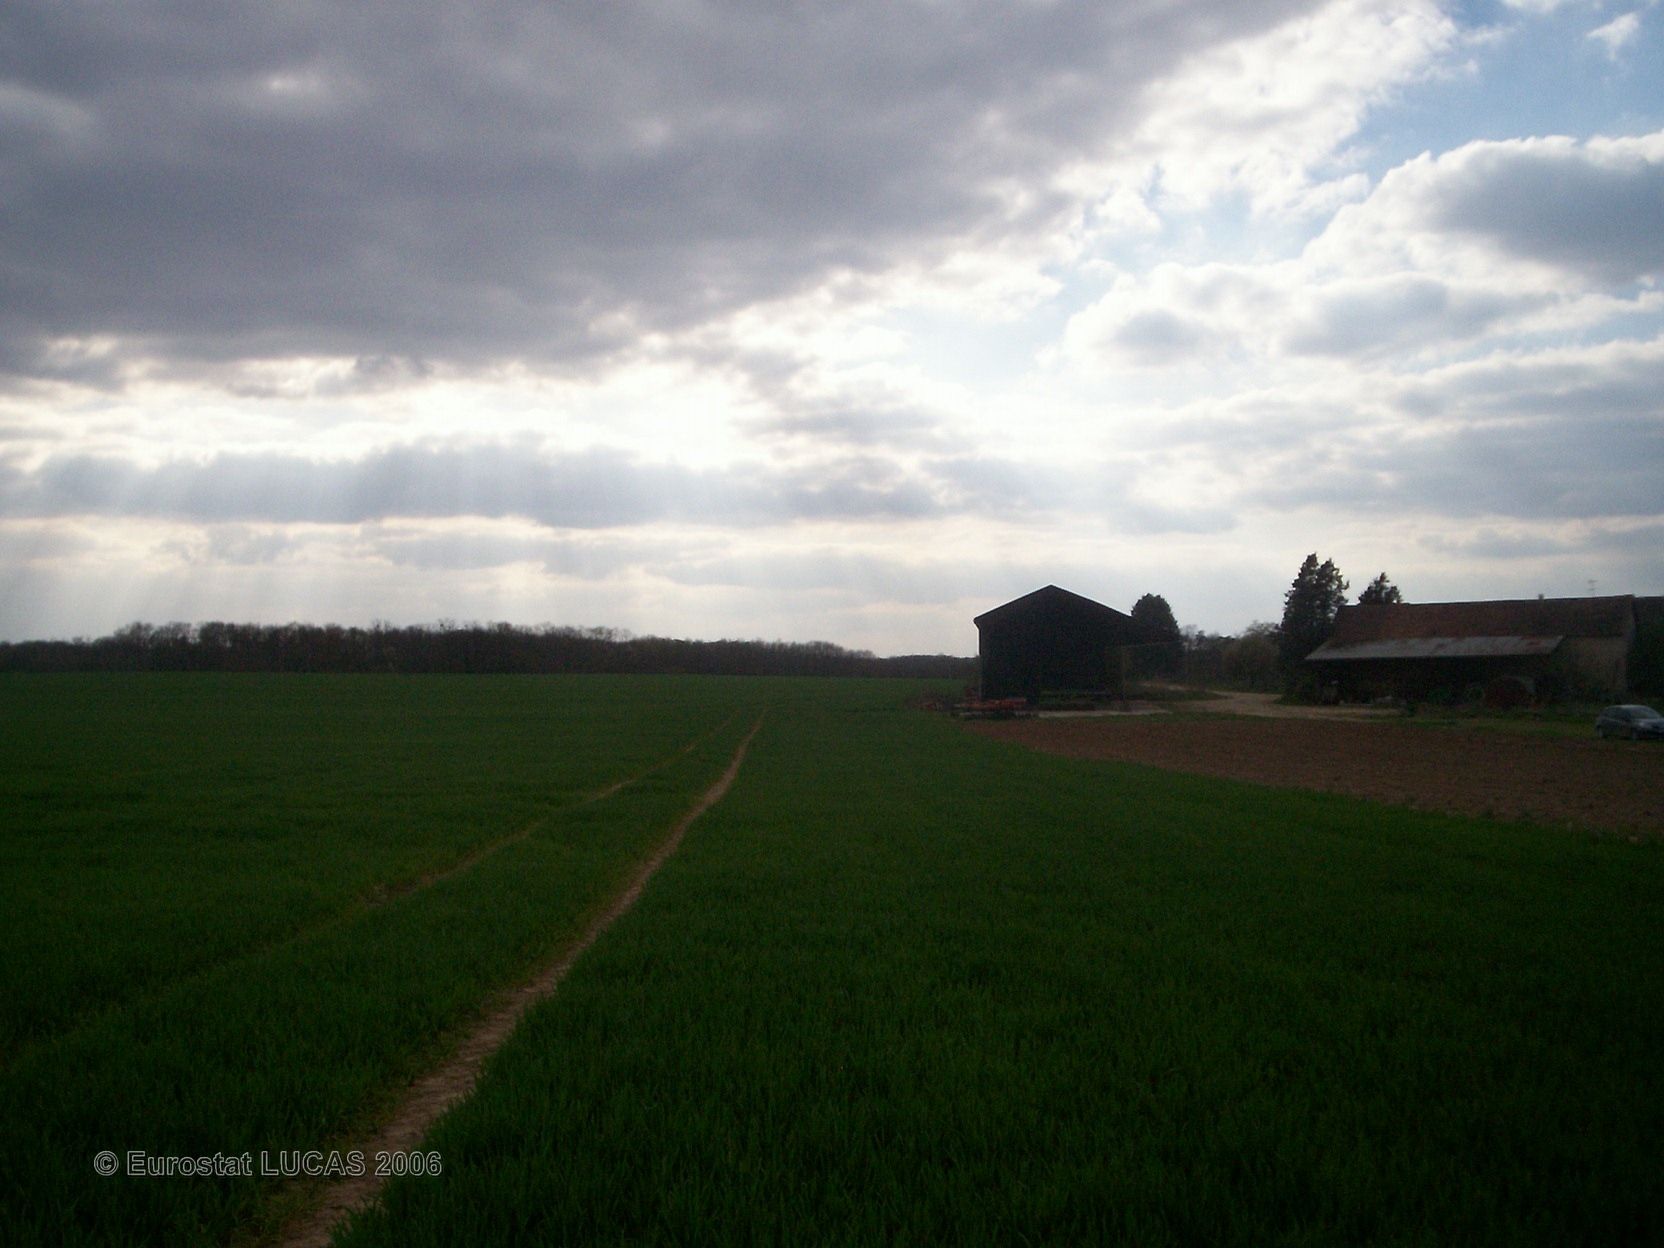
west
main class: Cropland
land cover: Common wheat
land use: Agriculture (excluding fallow land and kitchen gardens)
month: April
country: FR
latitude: 48.3008
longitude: 2.8873
